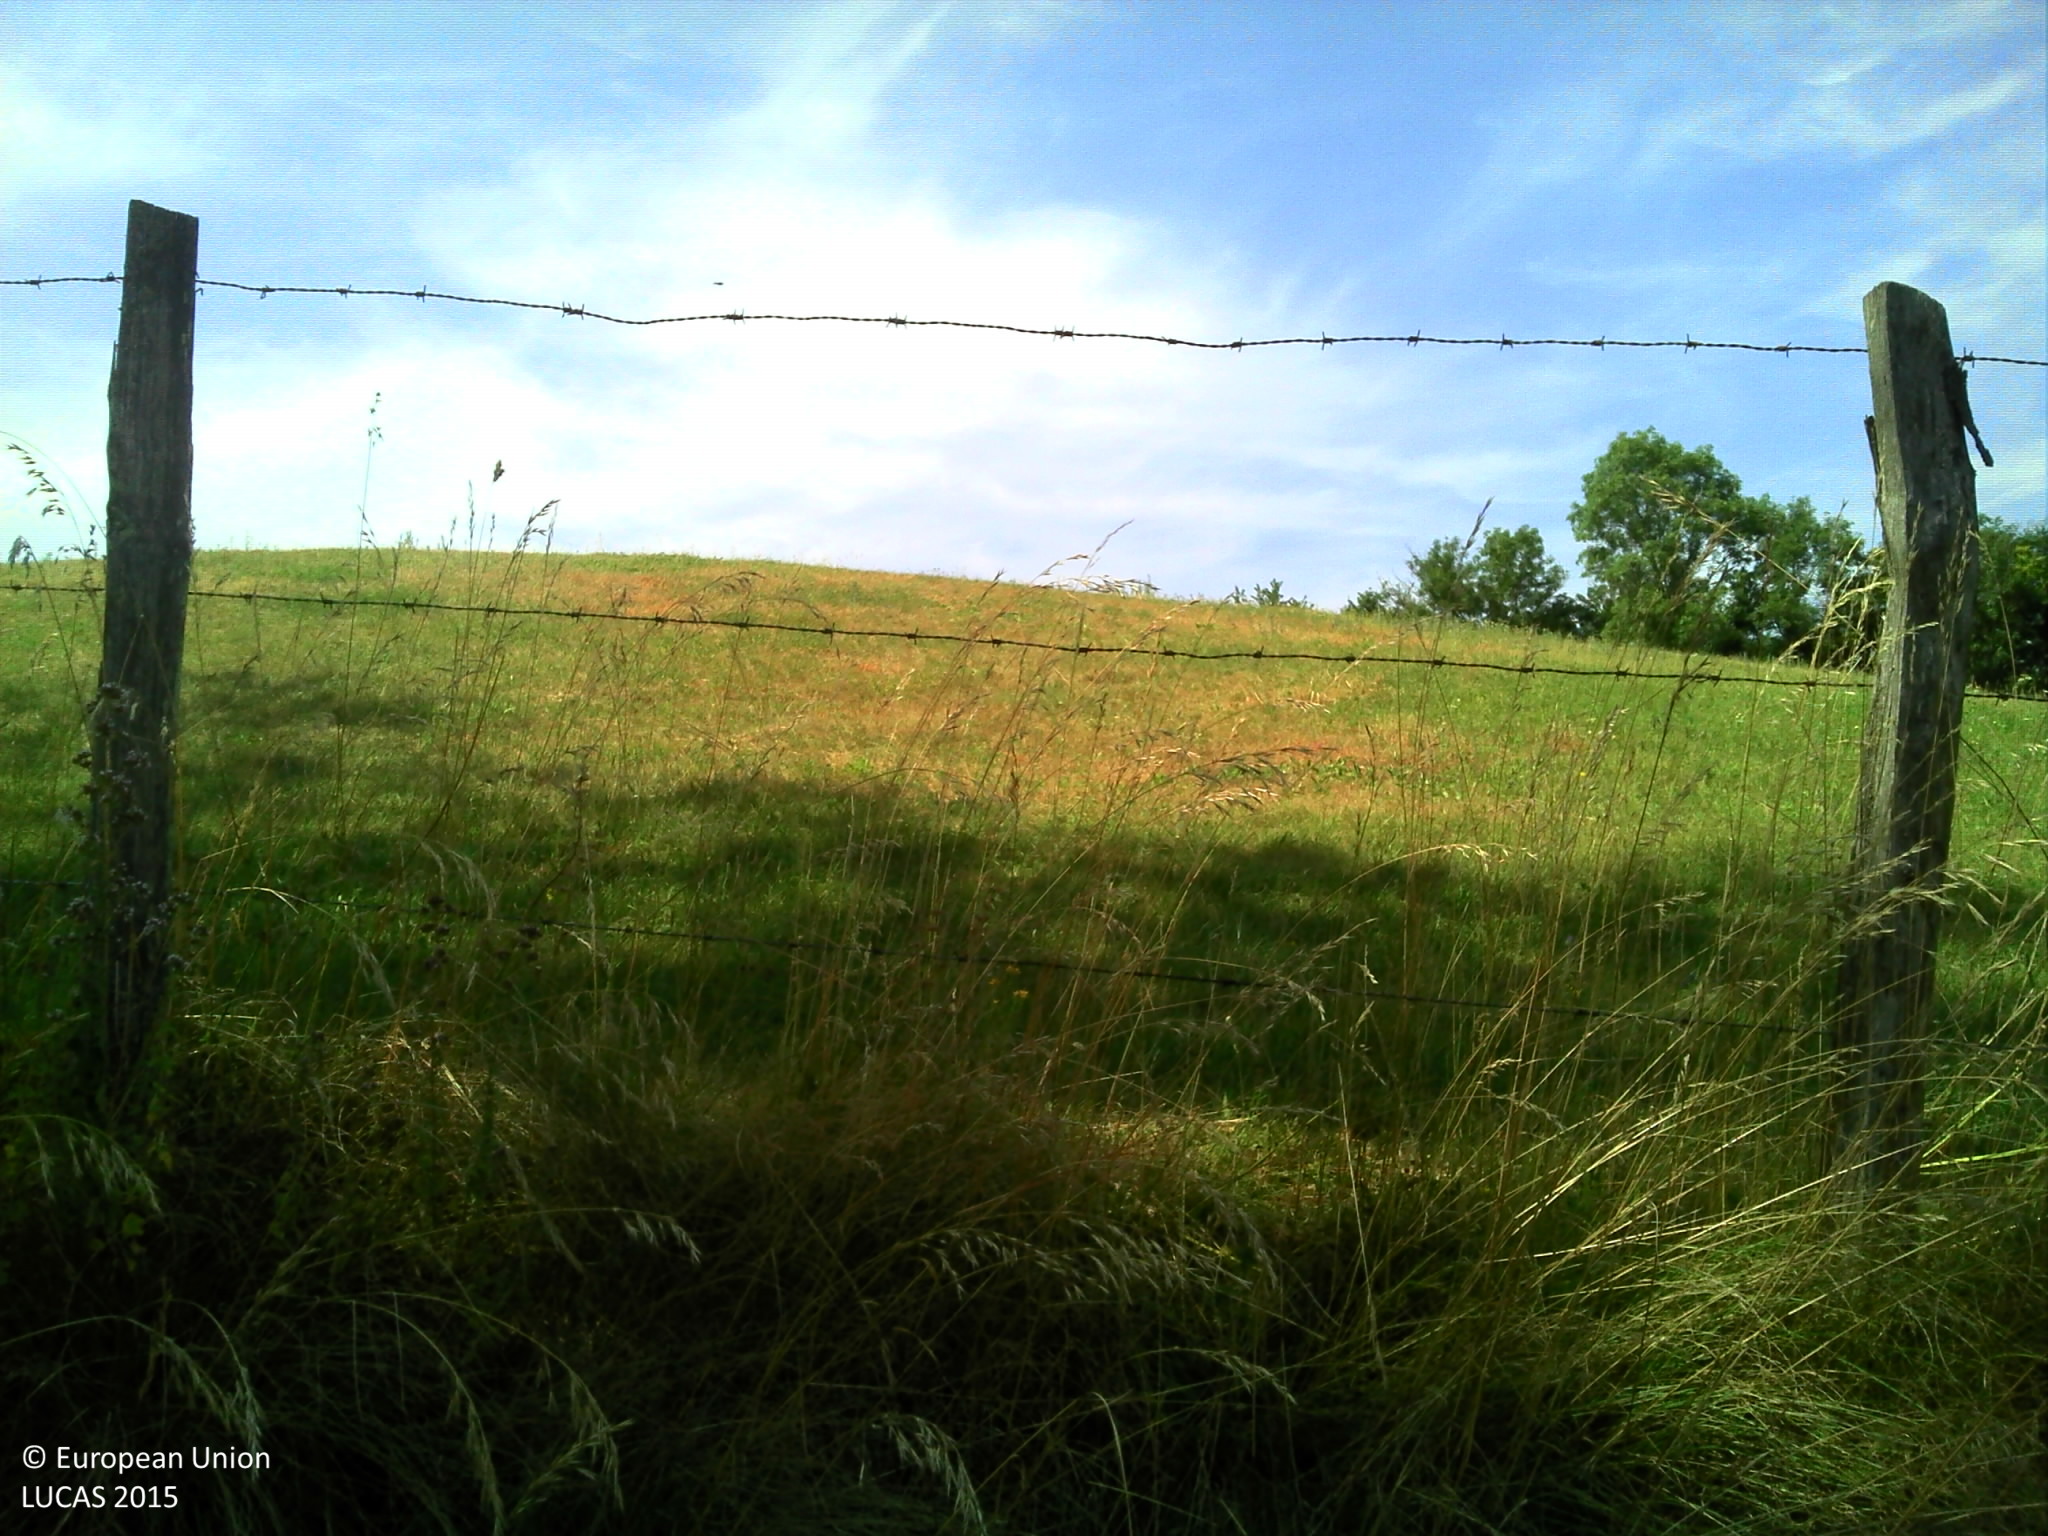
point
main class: Grassland
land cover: Grassland without tree/shrub cover
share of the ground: > 75 %
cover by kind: herbaceous plants 100 %
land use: Agriculture (excluding fallow land and kitchen gardens)
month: July
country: FR
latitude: 45.4600
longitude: 5.4392
